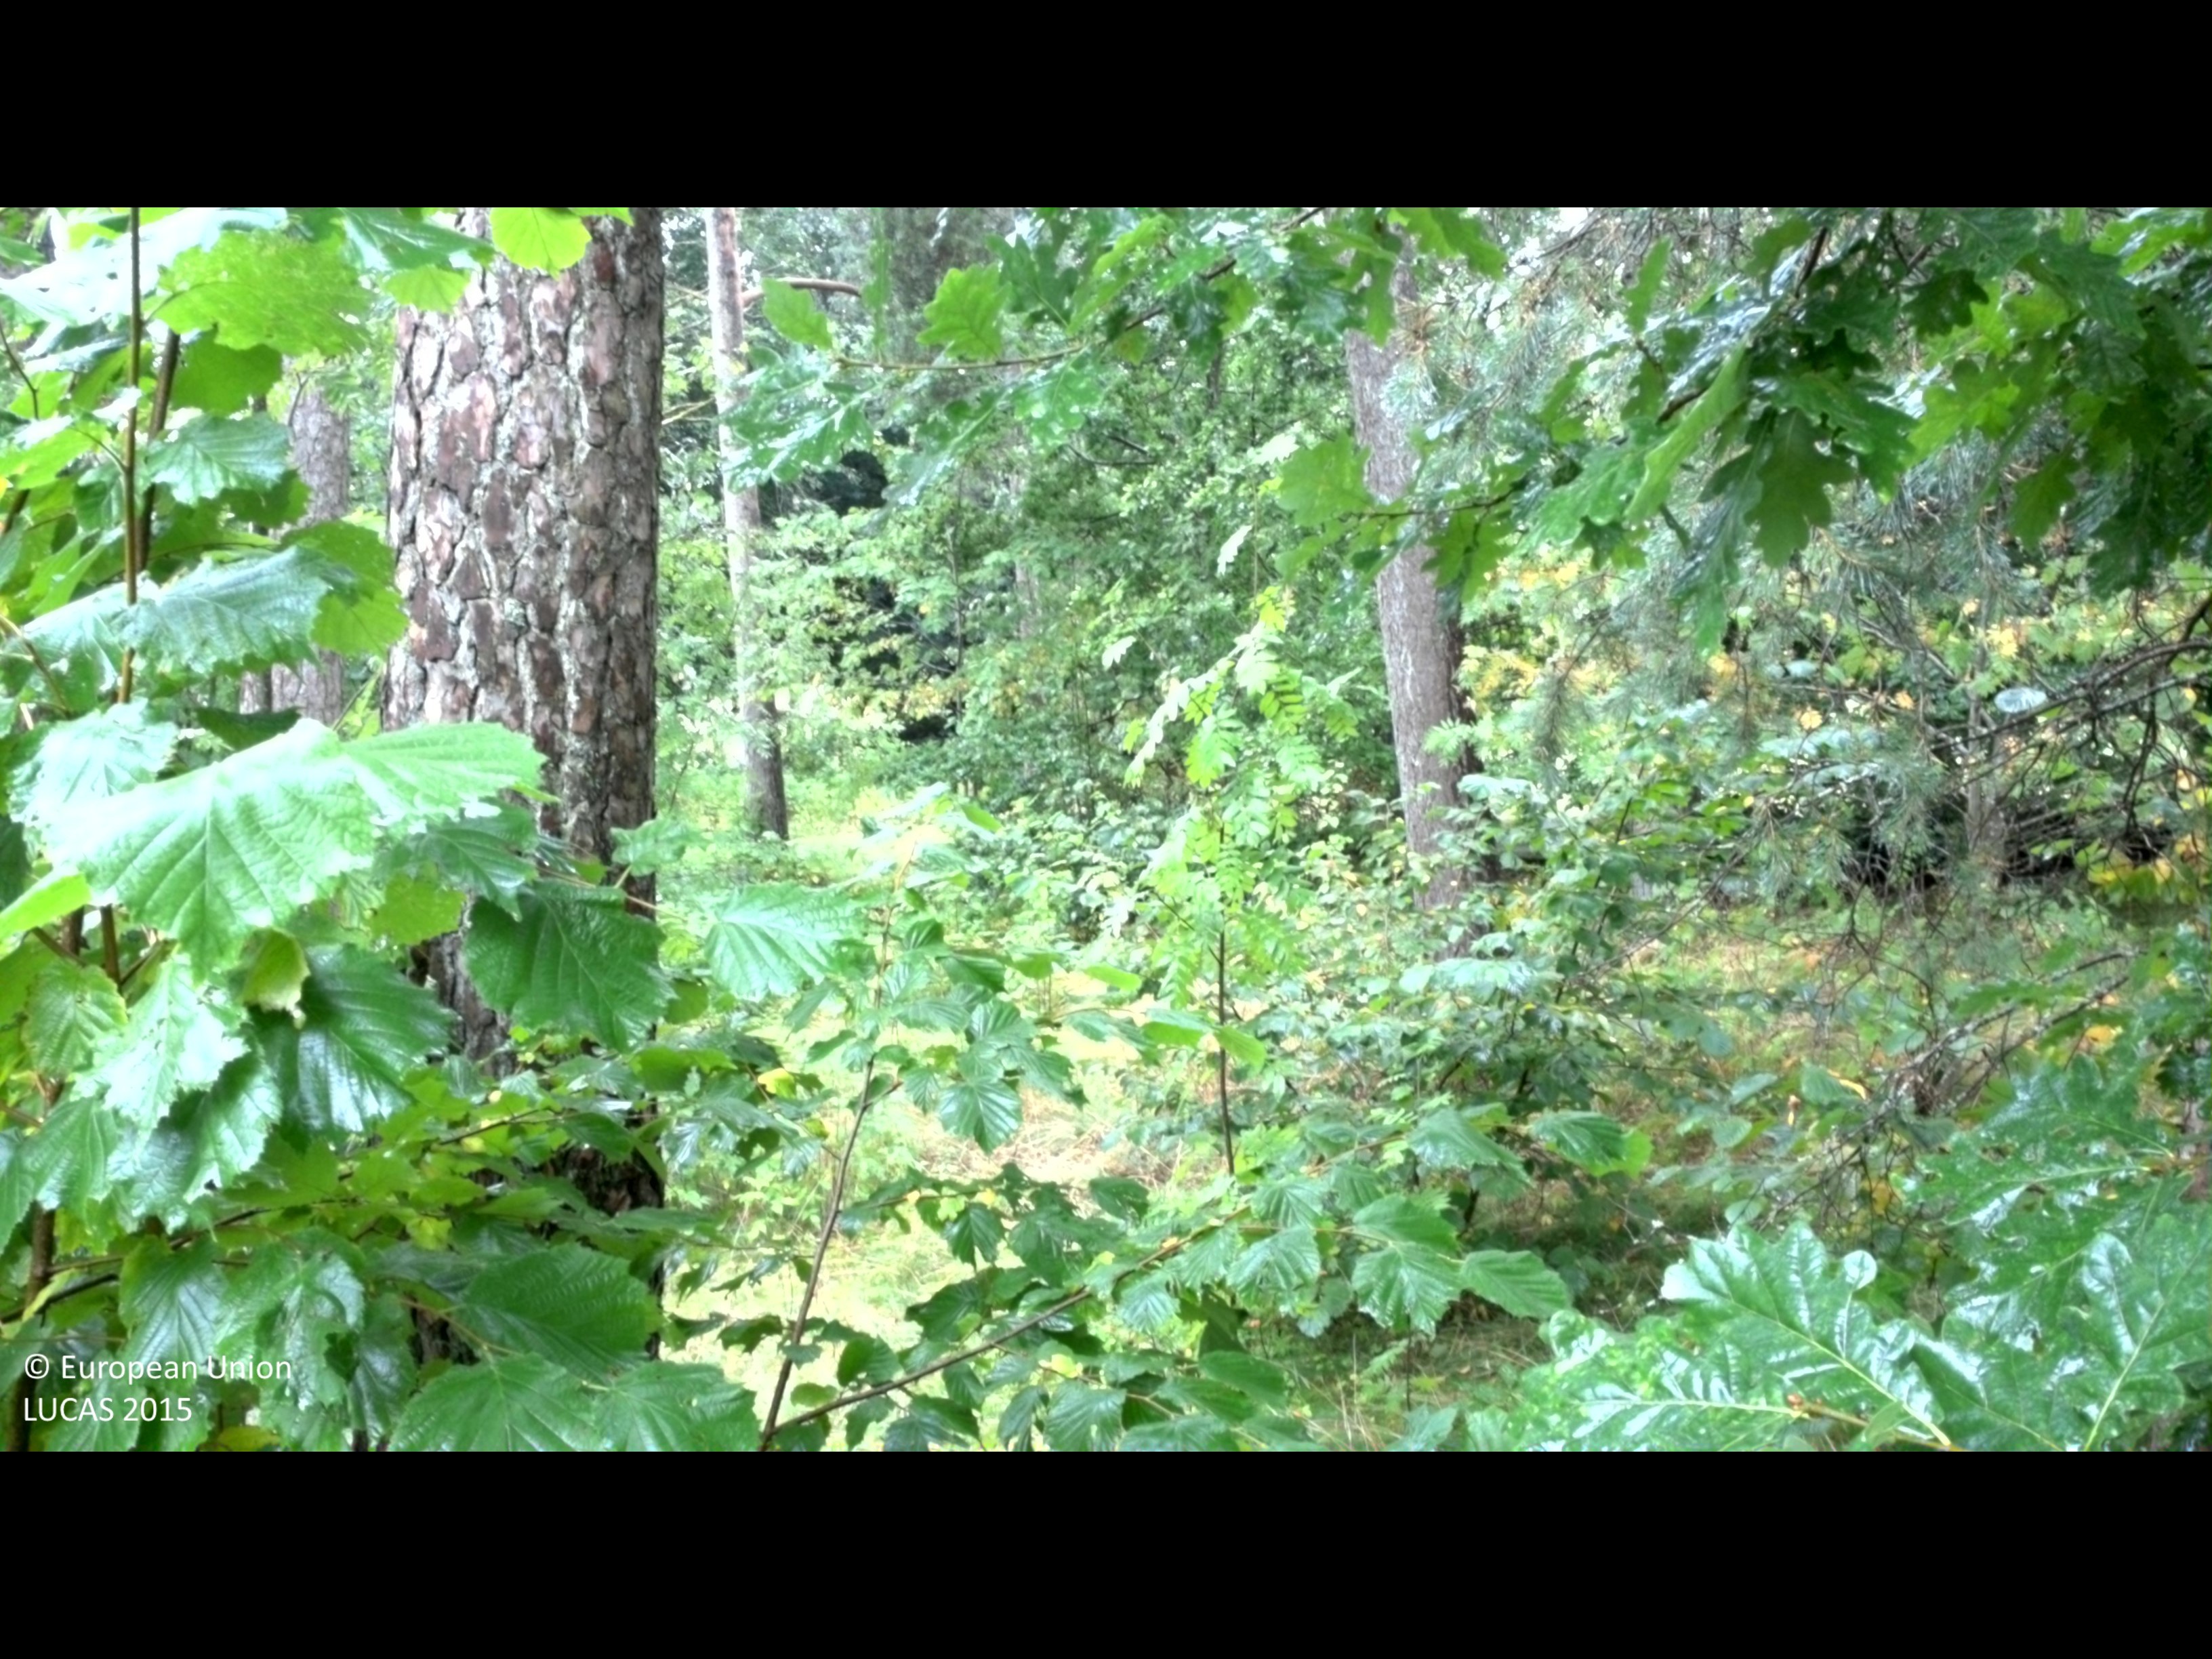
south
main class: Woodland
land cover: Pine dominated mixed woodland
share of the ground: 50 - 75 %
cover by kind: coniferous forest trees 45 %, herbaceous plants 25 %, broadleaved forest trees 20 %, shrubs 10 %
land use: Residential
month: August
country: SE
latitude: 56.9591
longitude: 13.1374
